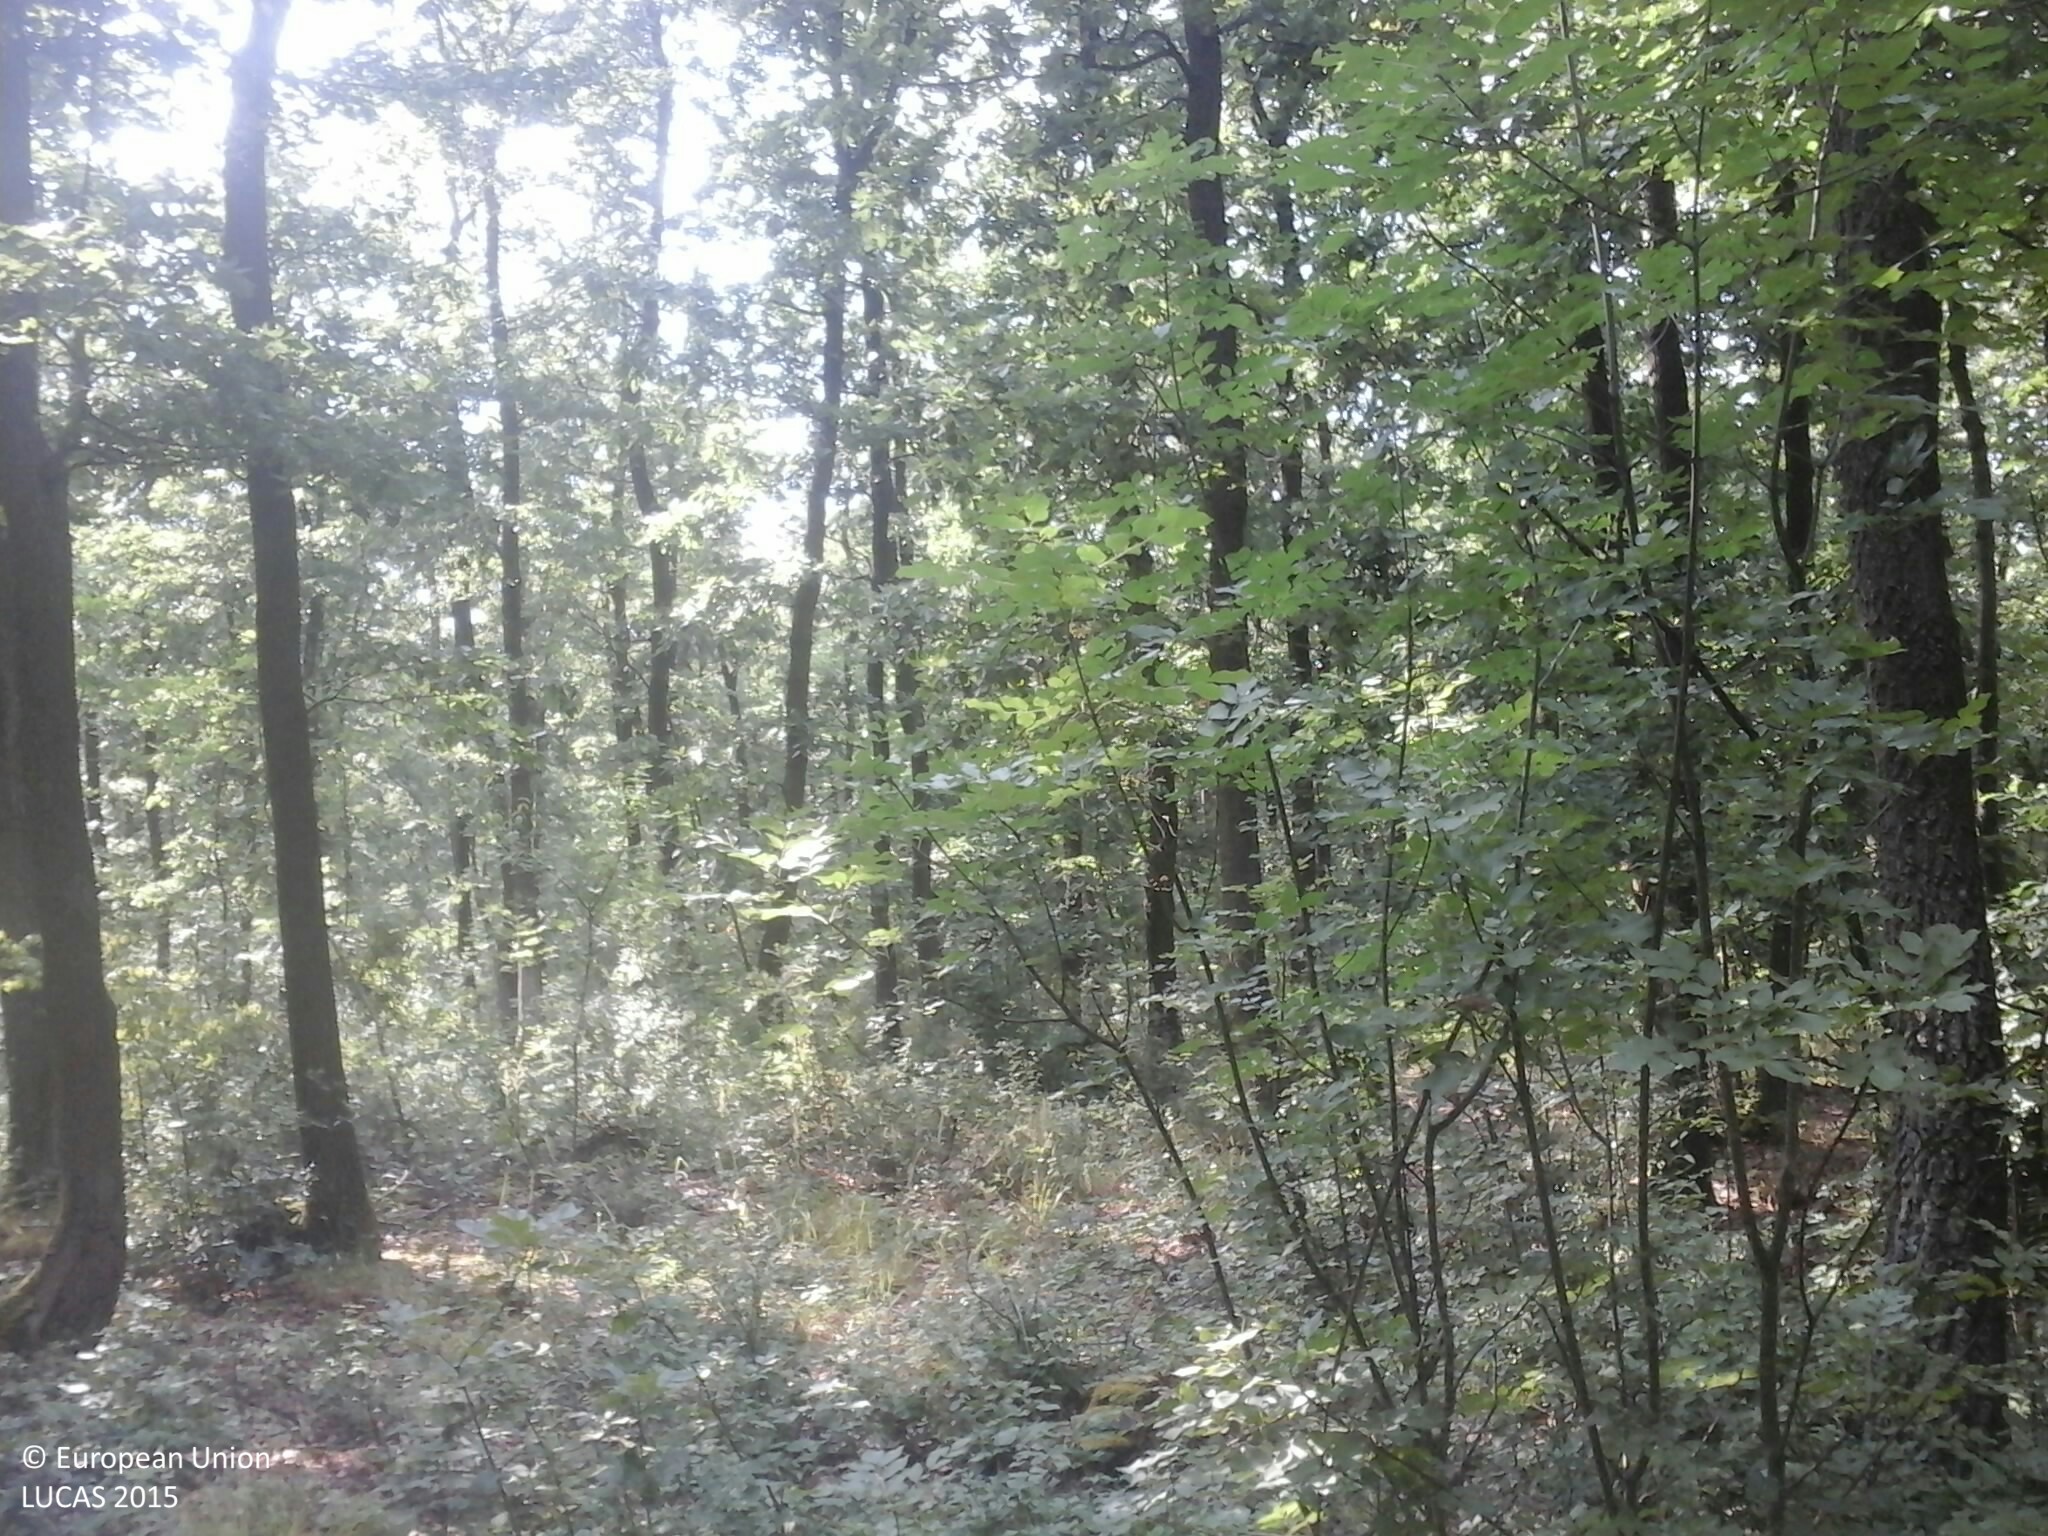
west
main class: Woodland
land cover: Broadleaved woodland
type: acidophilous oak and oak-birch forest
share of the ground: > 75 %
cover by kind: broadleaved forest trees 95 %, shrubs 5 %
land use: Forestry
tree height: > 5 m
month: July
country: HU
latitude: 46.9186
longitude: 17.7682
